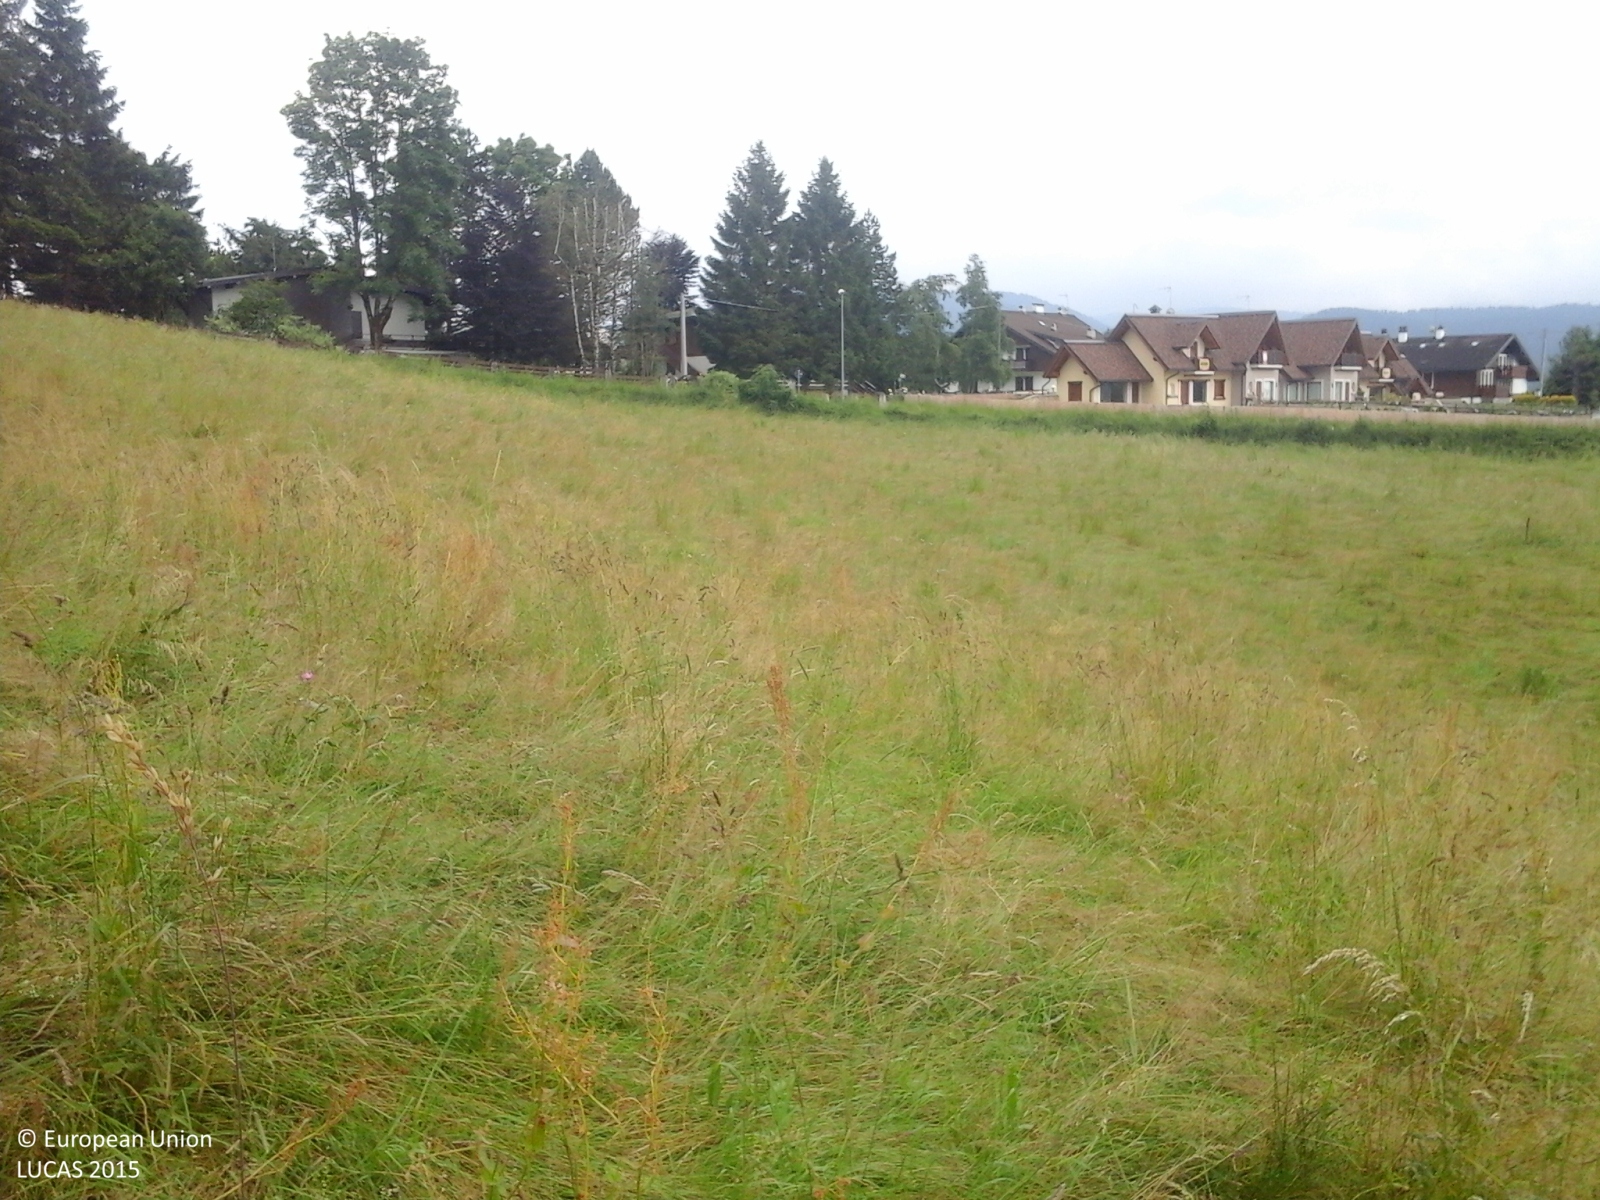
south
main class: Grassland
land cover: Grassland without tree/shrub cover
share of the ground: > 75 %
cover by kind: herbaceous plants 100 %
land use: Agriculture (excluding fallow land and kitchen gardens)
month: June
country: IT
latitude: 45.8718
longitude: 11.5308
